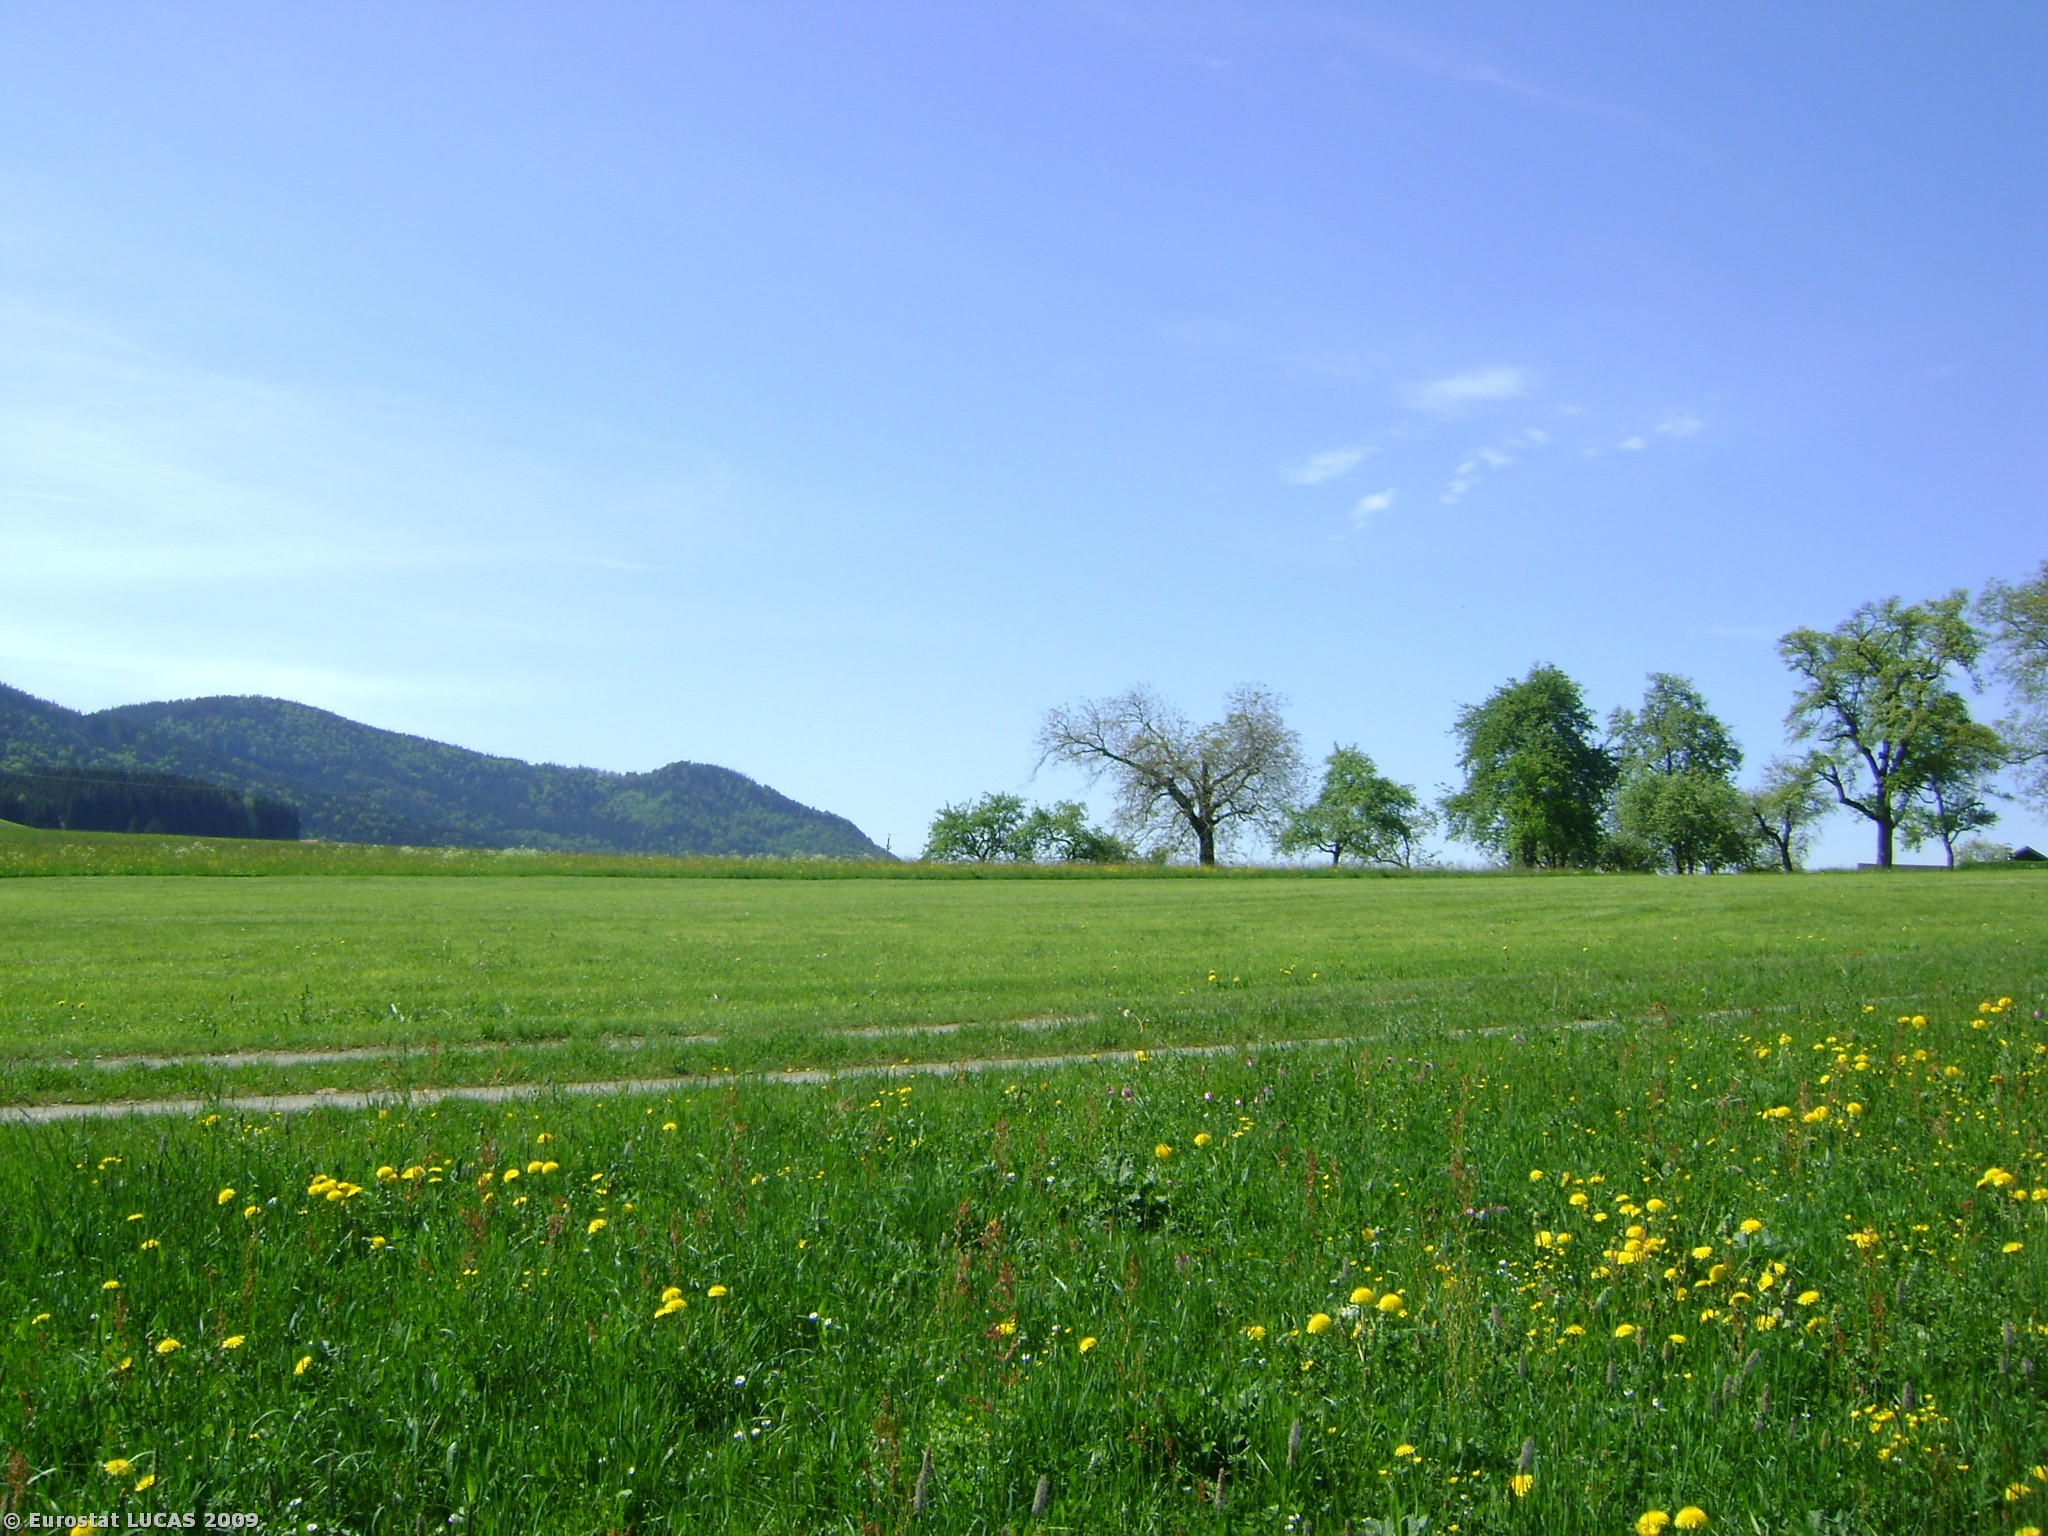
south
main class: Grassland
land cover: Grassland without tree/shrub cover
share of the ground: > 75 %
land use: Agriculture (excluding fallow land and kitchen gardens)
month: May
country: AT
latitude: 47.9063
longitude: 13.2230
